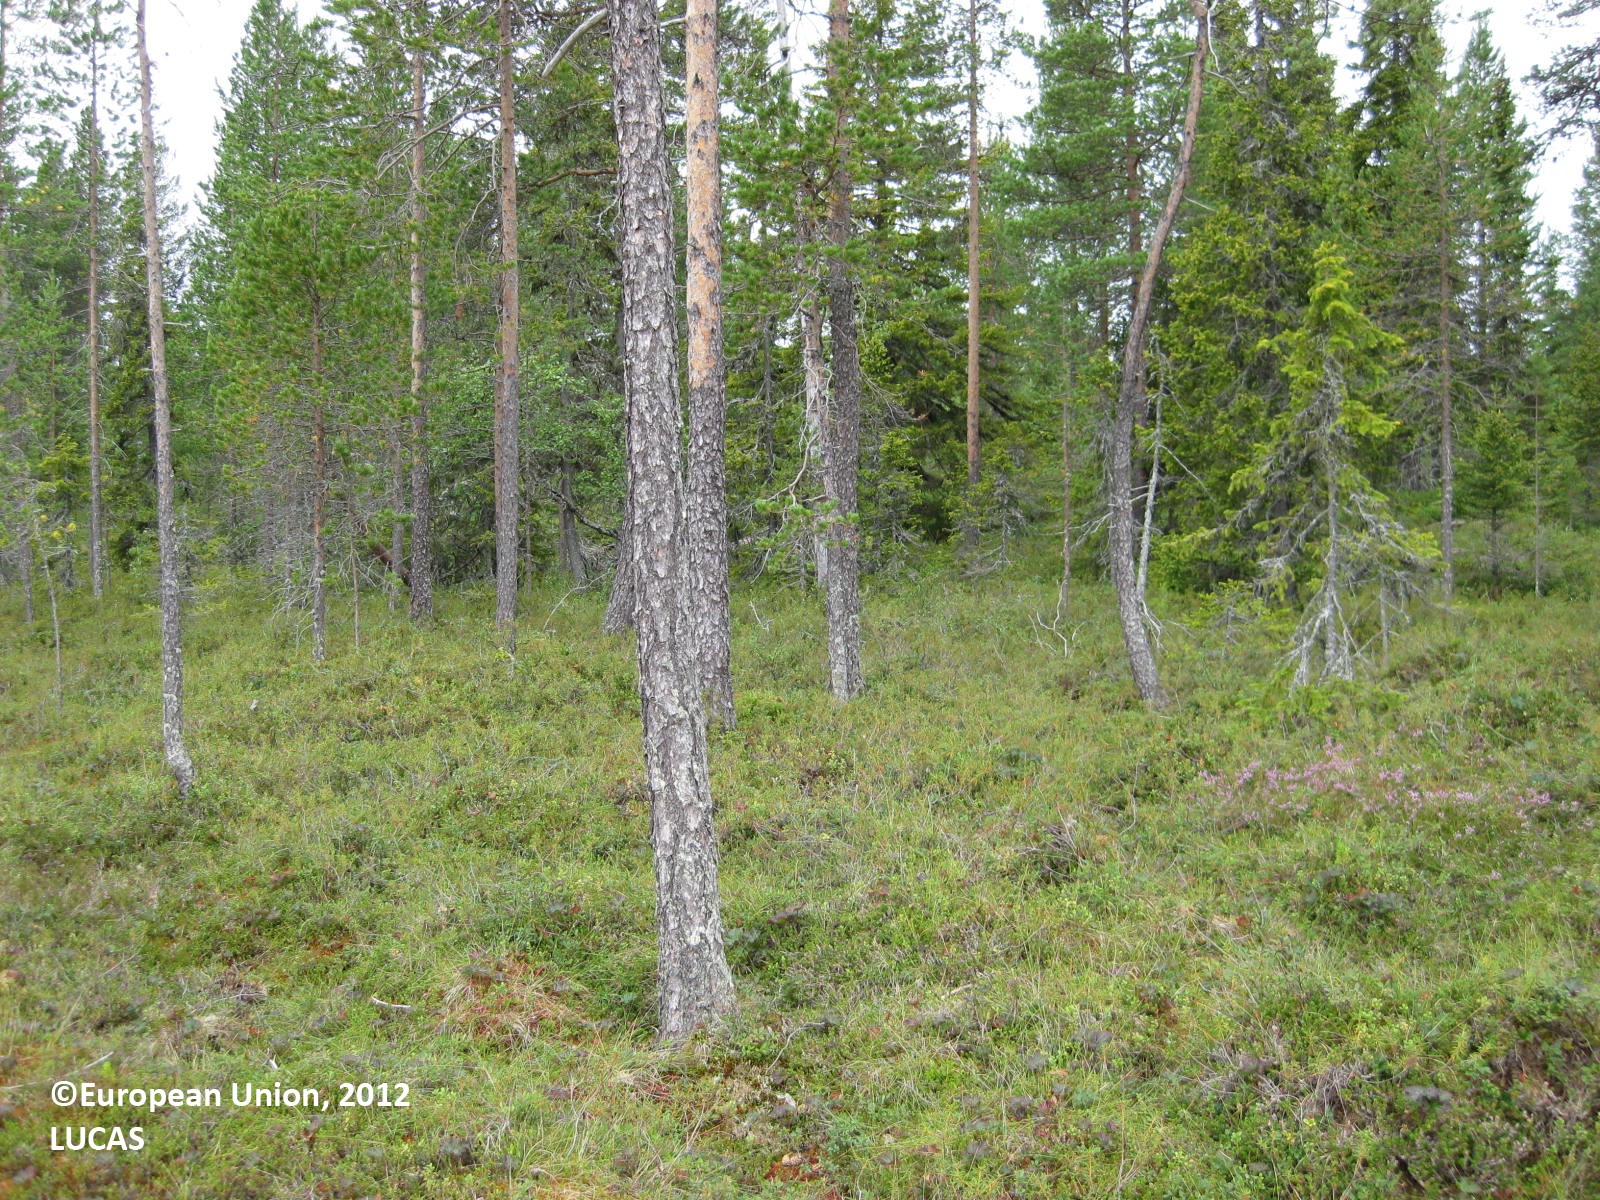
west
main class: Woodland
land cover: Pine dominated coniferous woodland
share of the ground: 25 - 50 %
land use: Semi-natural and natural areas not in use
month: August
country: FI
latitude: 66.3020
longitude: 28.3612
